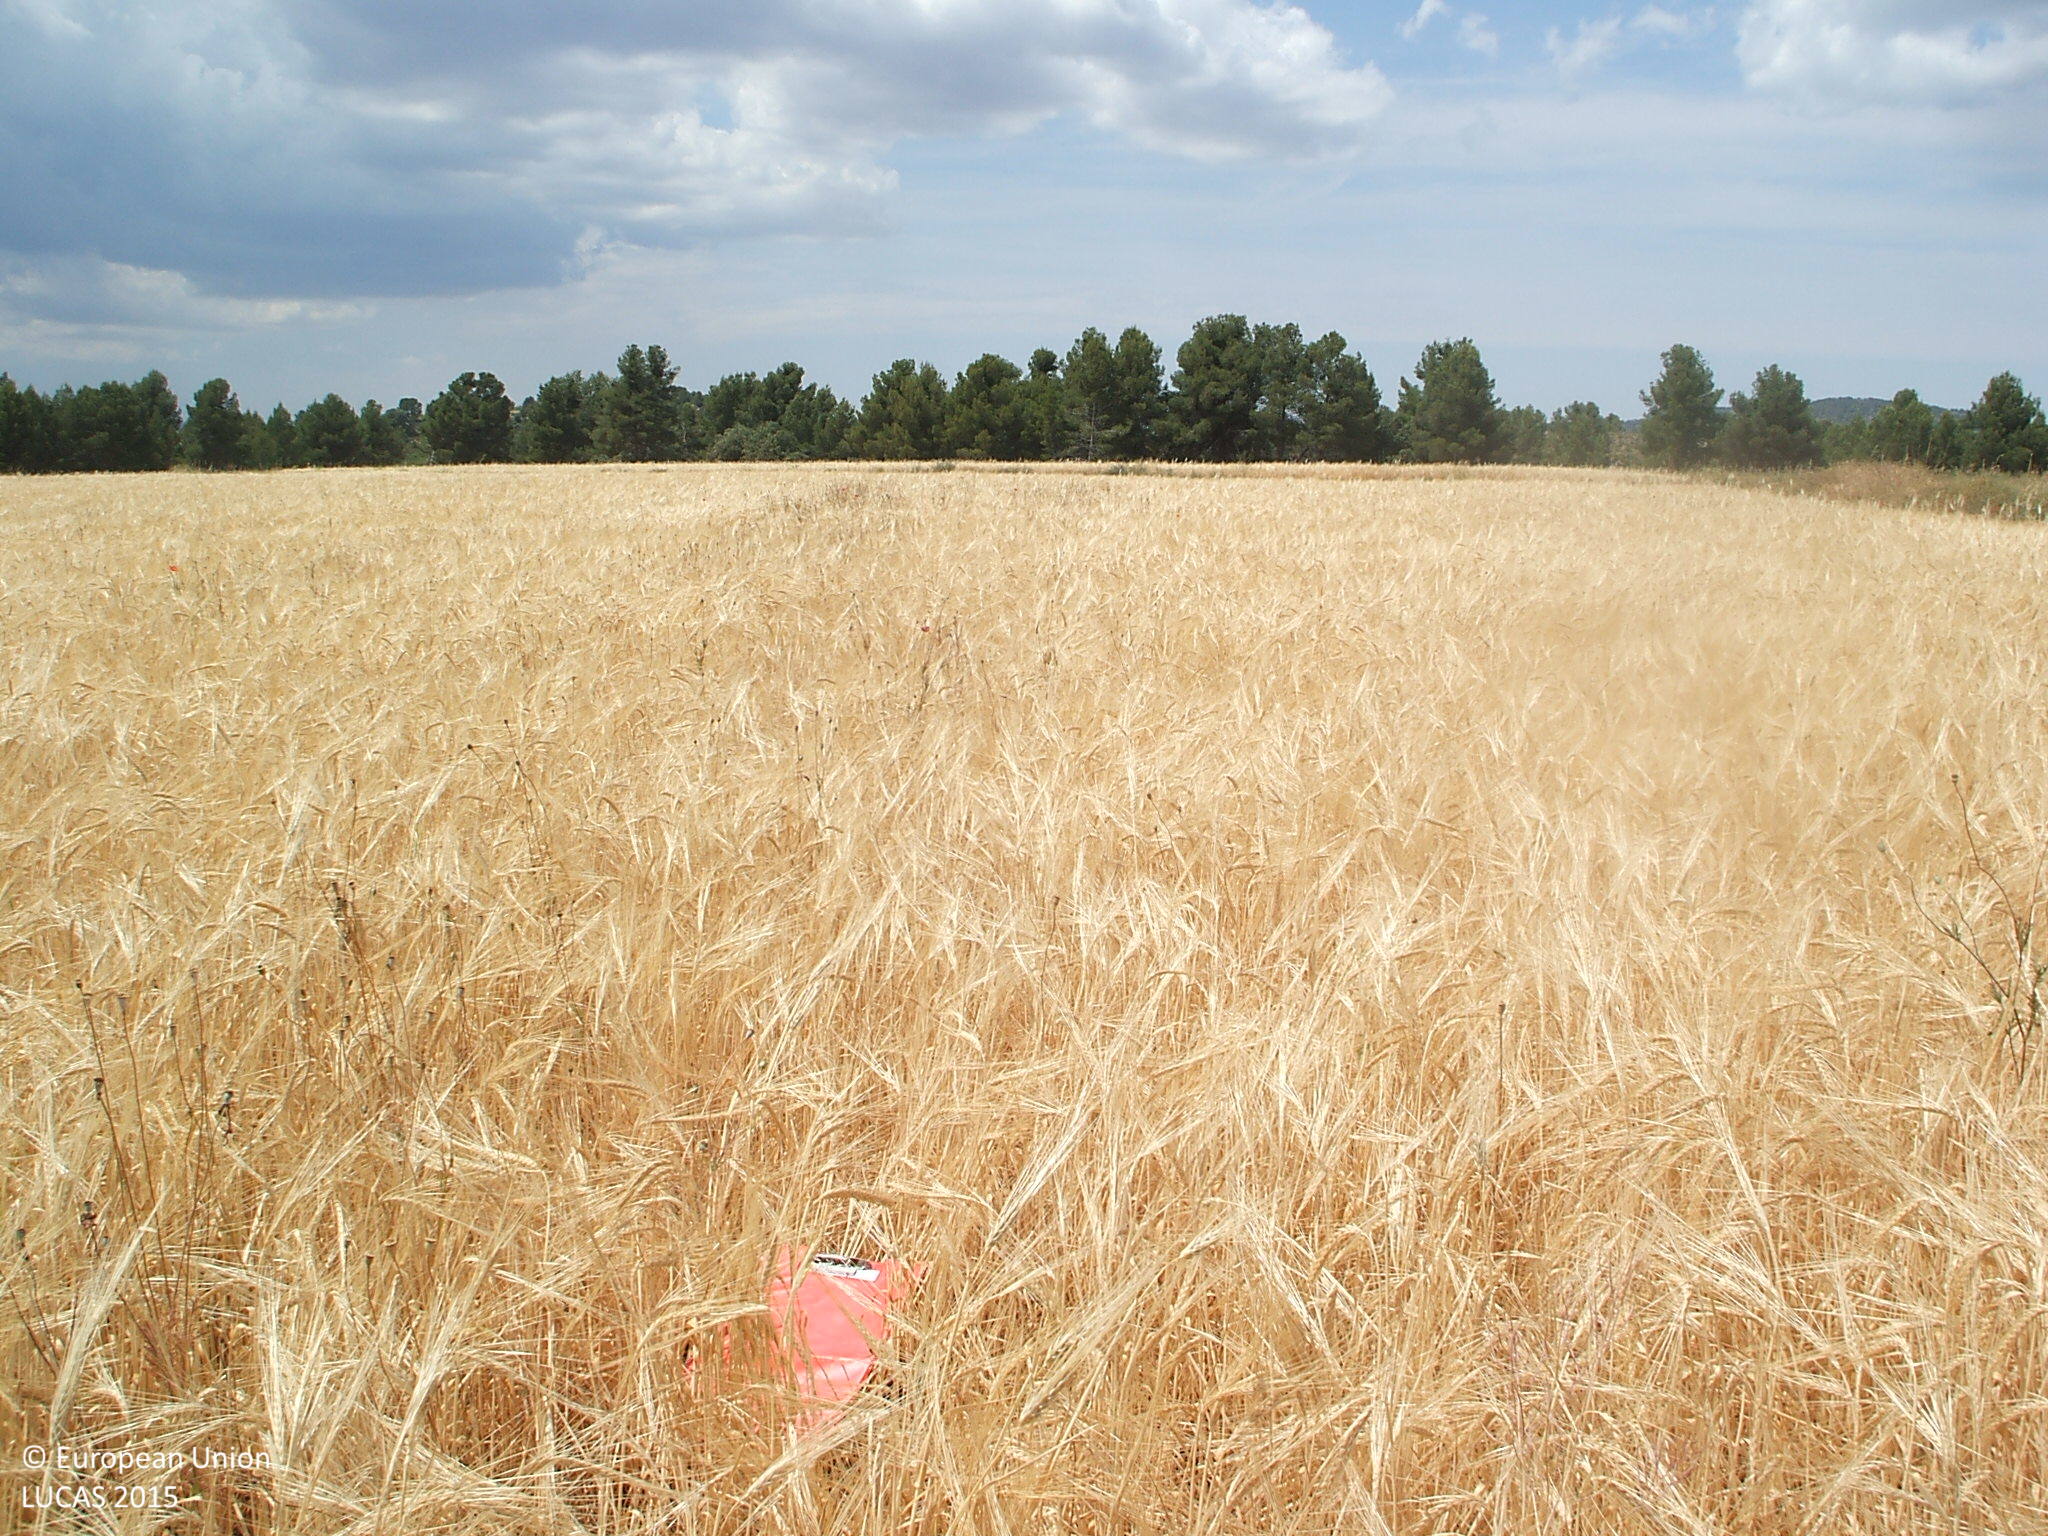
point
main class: Cropland
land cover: Barley
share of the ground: > 75 %
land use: Agriculture (excluding fallow land and kitchen gardens)
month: June
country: ES
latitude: 40.8148
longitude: -0.1457
